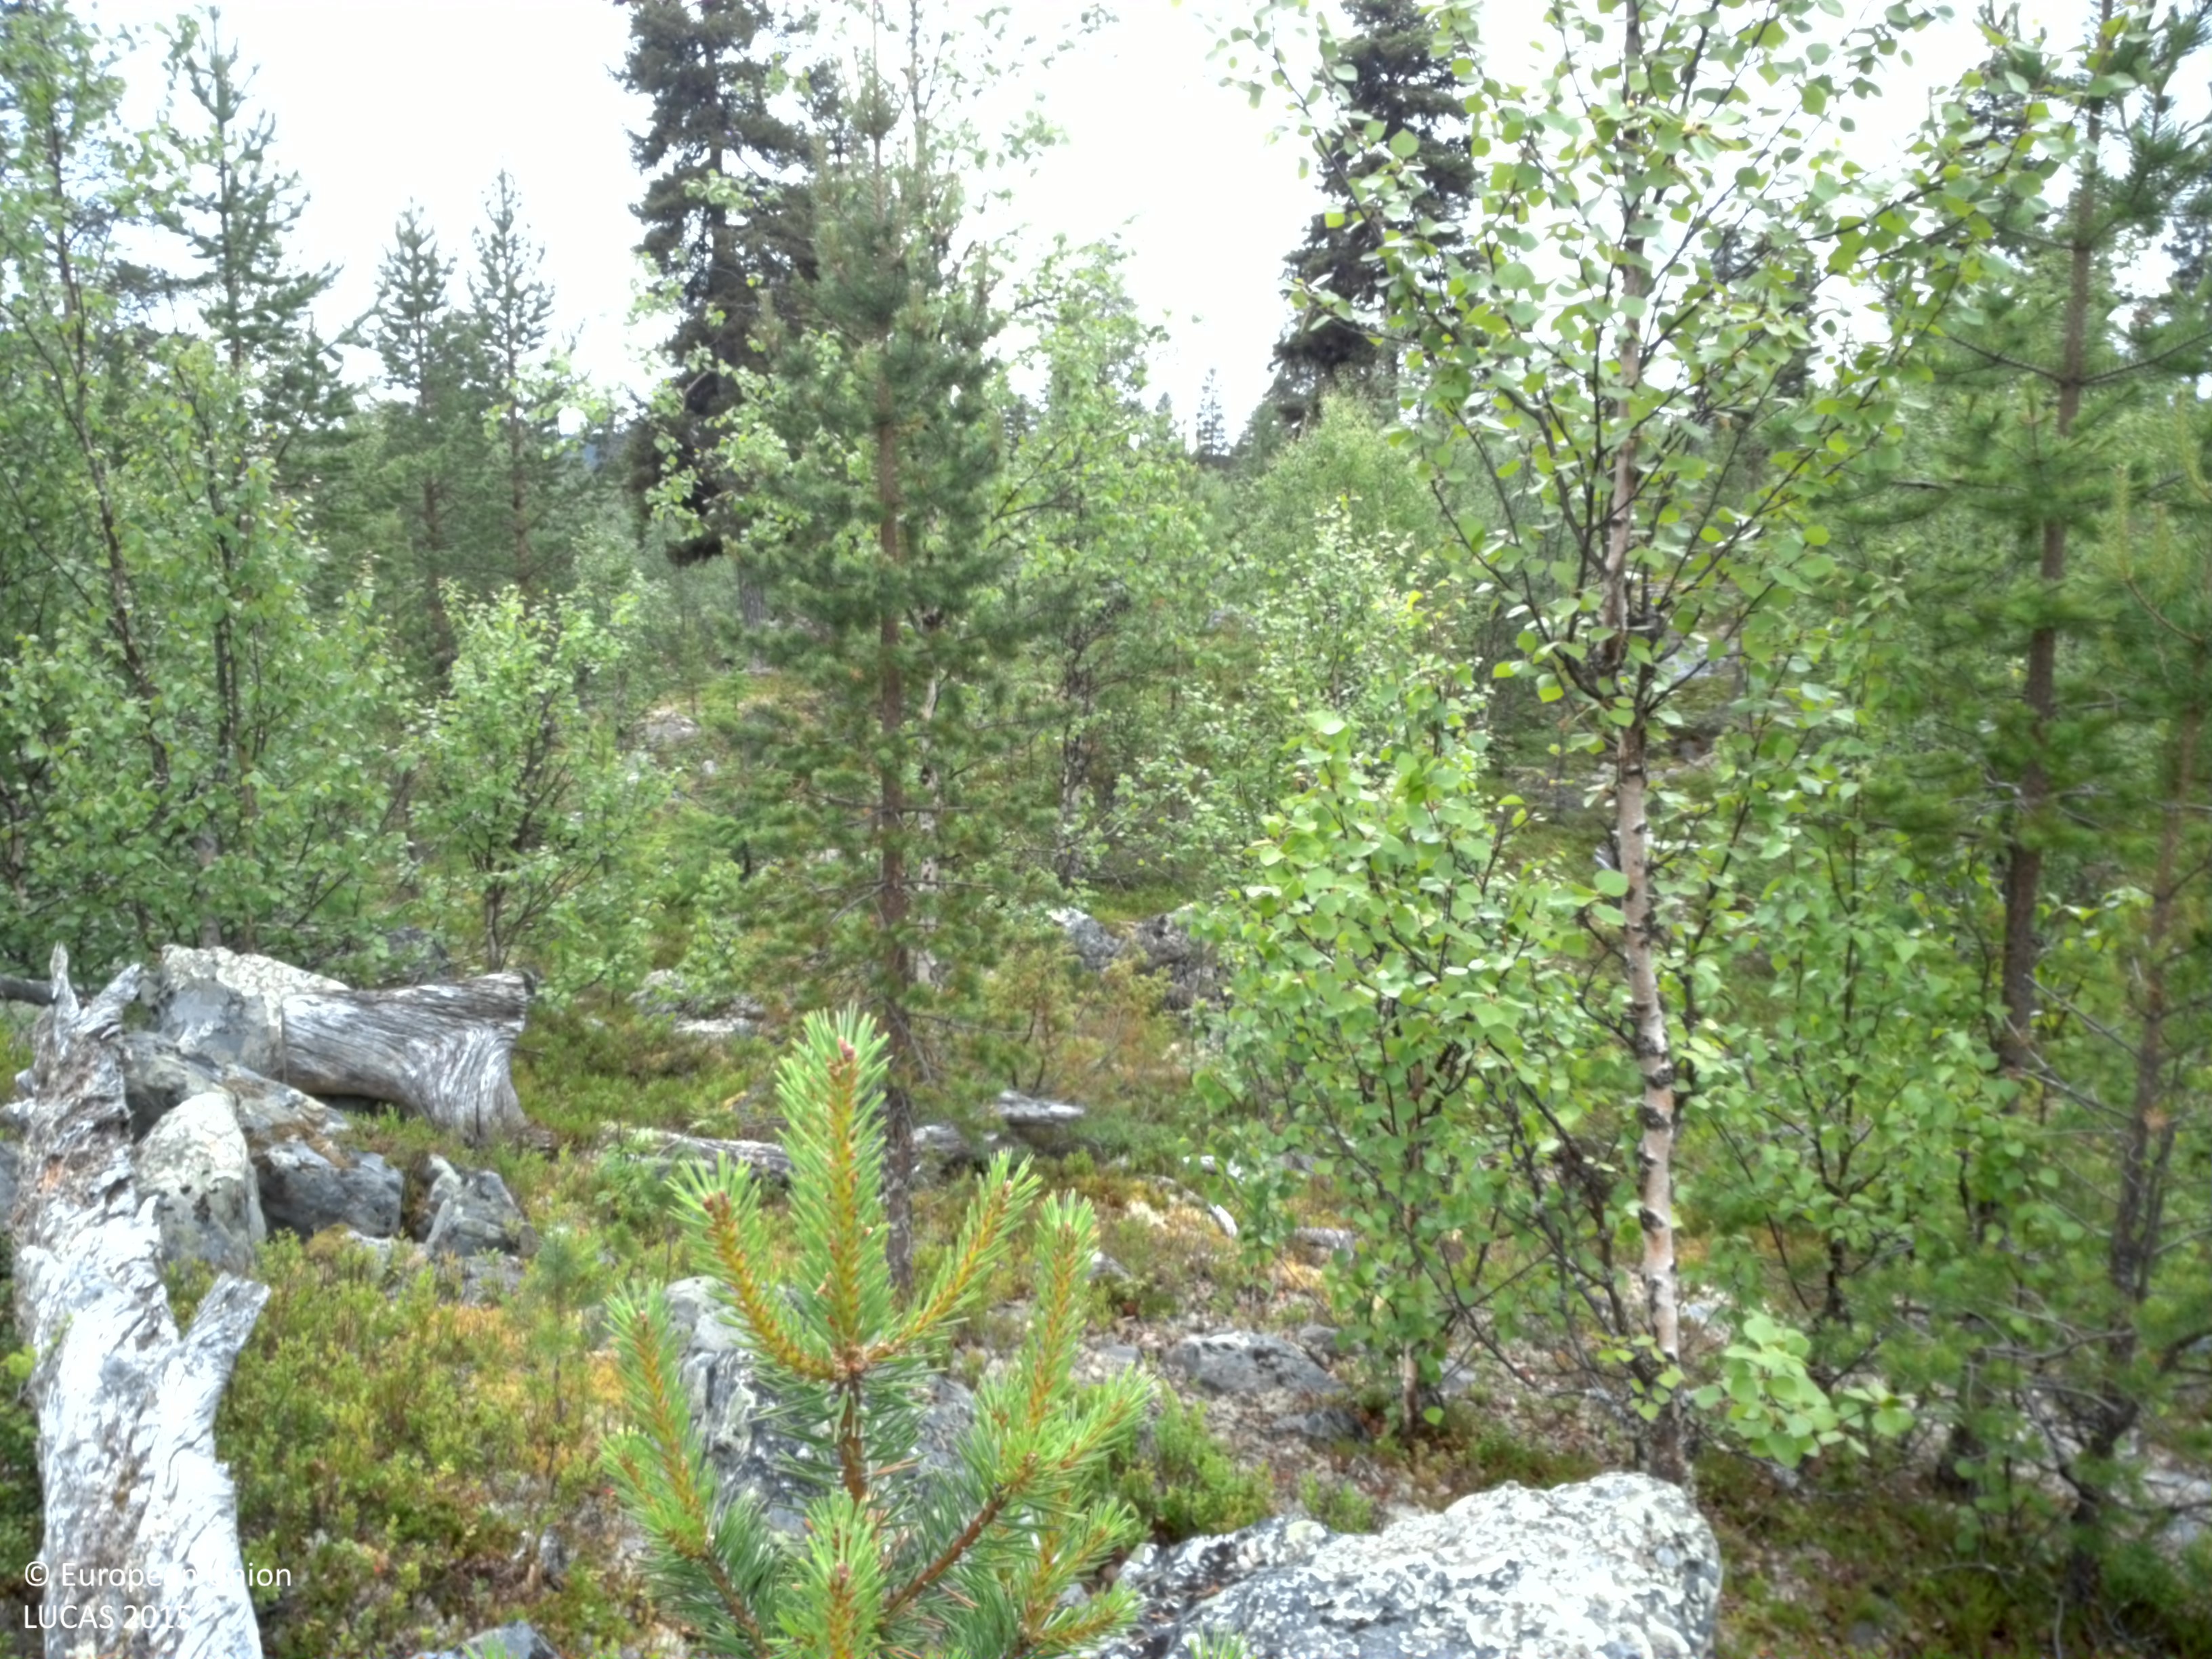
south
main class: Woodland
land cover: Pine dominated mixed woodland
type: exotic forest
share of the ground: 10 - 25 %
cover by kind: shrubs 35 %, lichens and mosses 30 %, consolidated bare surface 15 %, coniferous forest trees 10 %, broadleaved forest trees 10 %
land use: Forestry
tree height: < 5 m
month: August
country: SE
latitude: 65.0566
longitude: 16.1918
